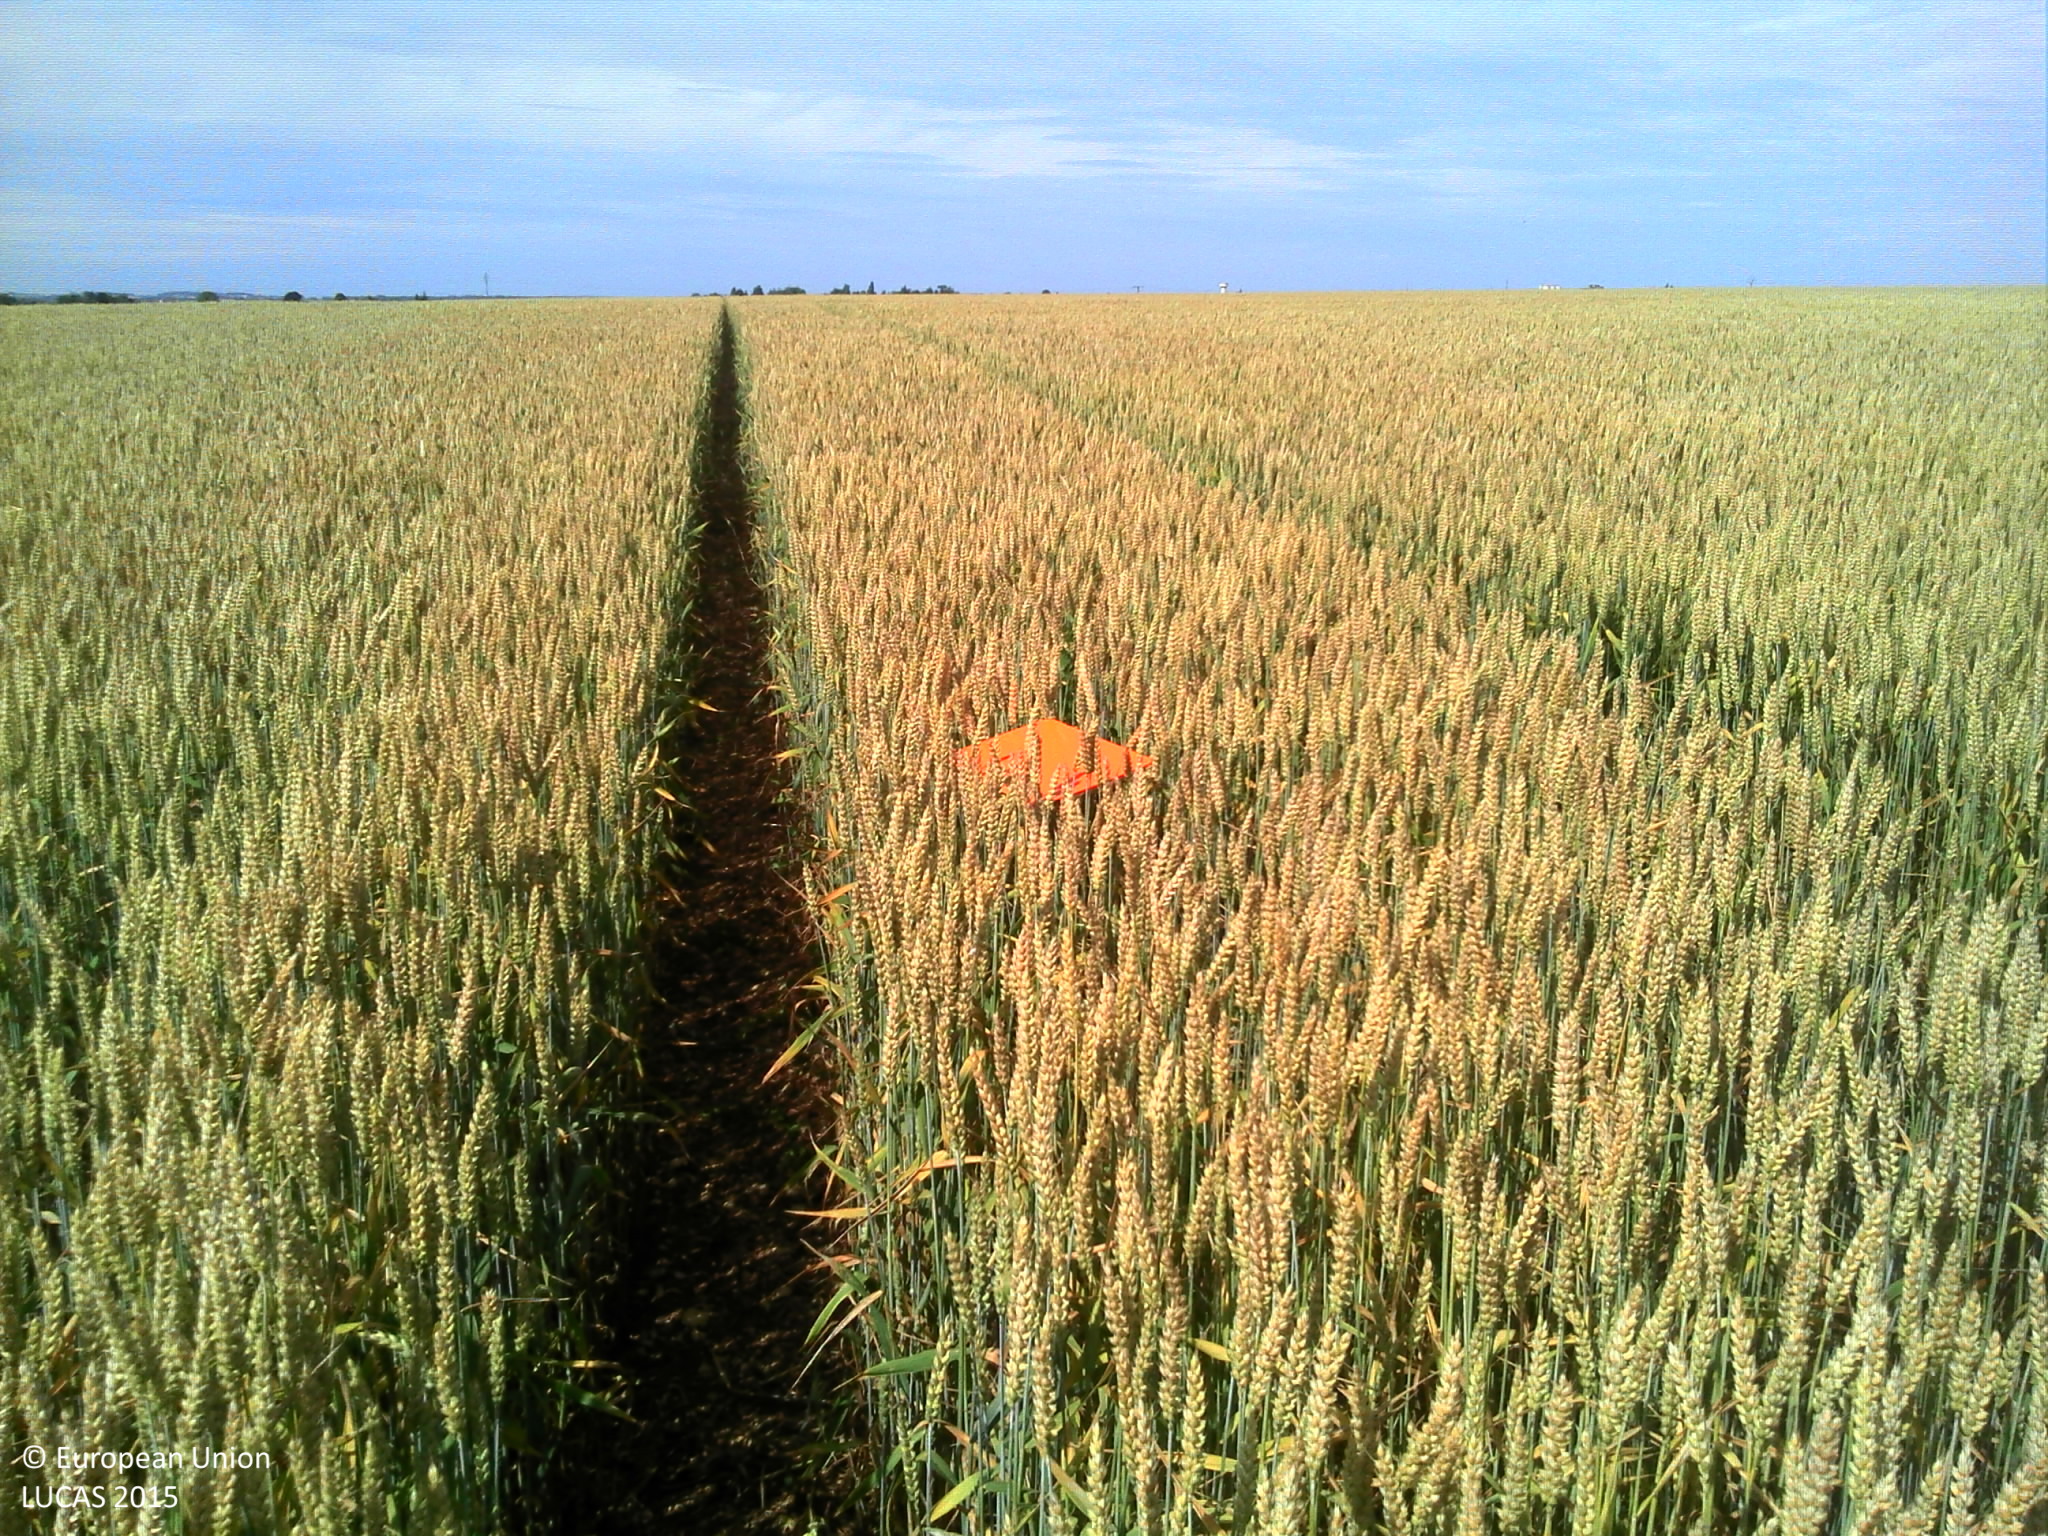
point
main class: Cropland
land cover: Common wheat
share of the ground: > 75 %
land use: Agriculture (excluding fallow land and kitchen gardens)
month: June
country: FR
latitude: 46.6634
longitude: 0.2166
